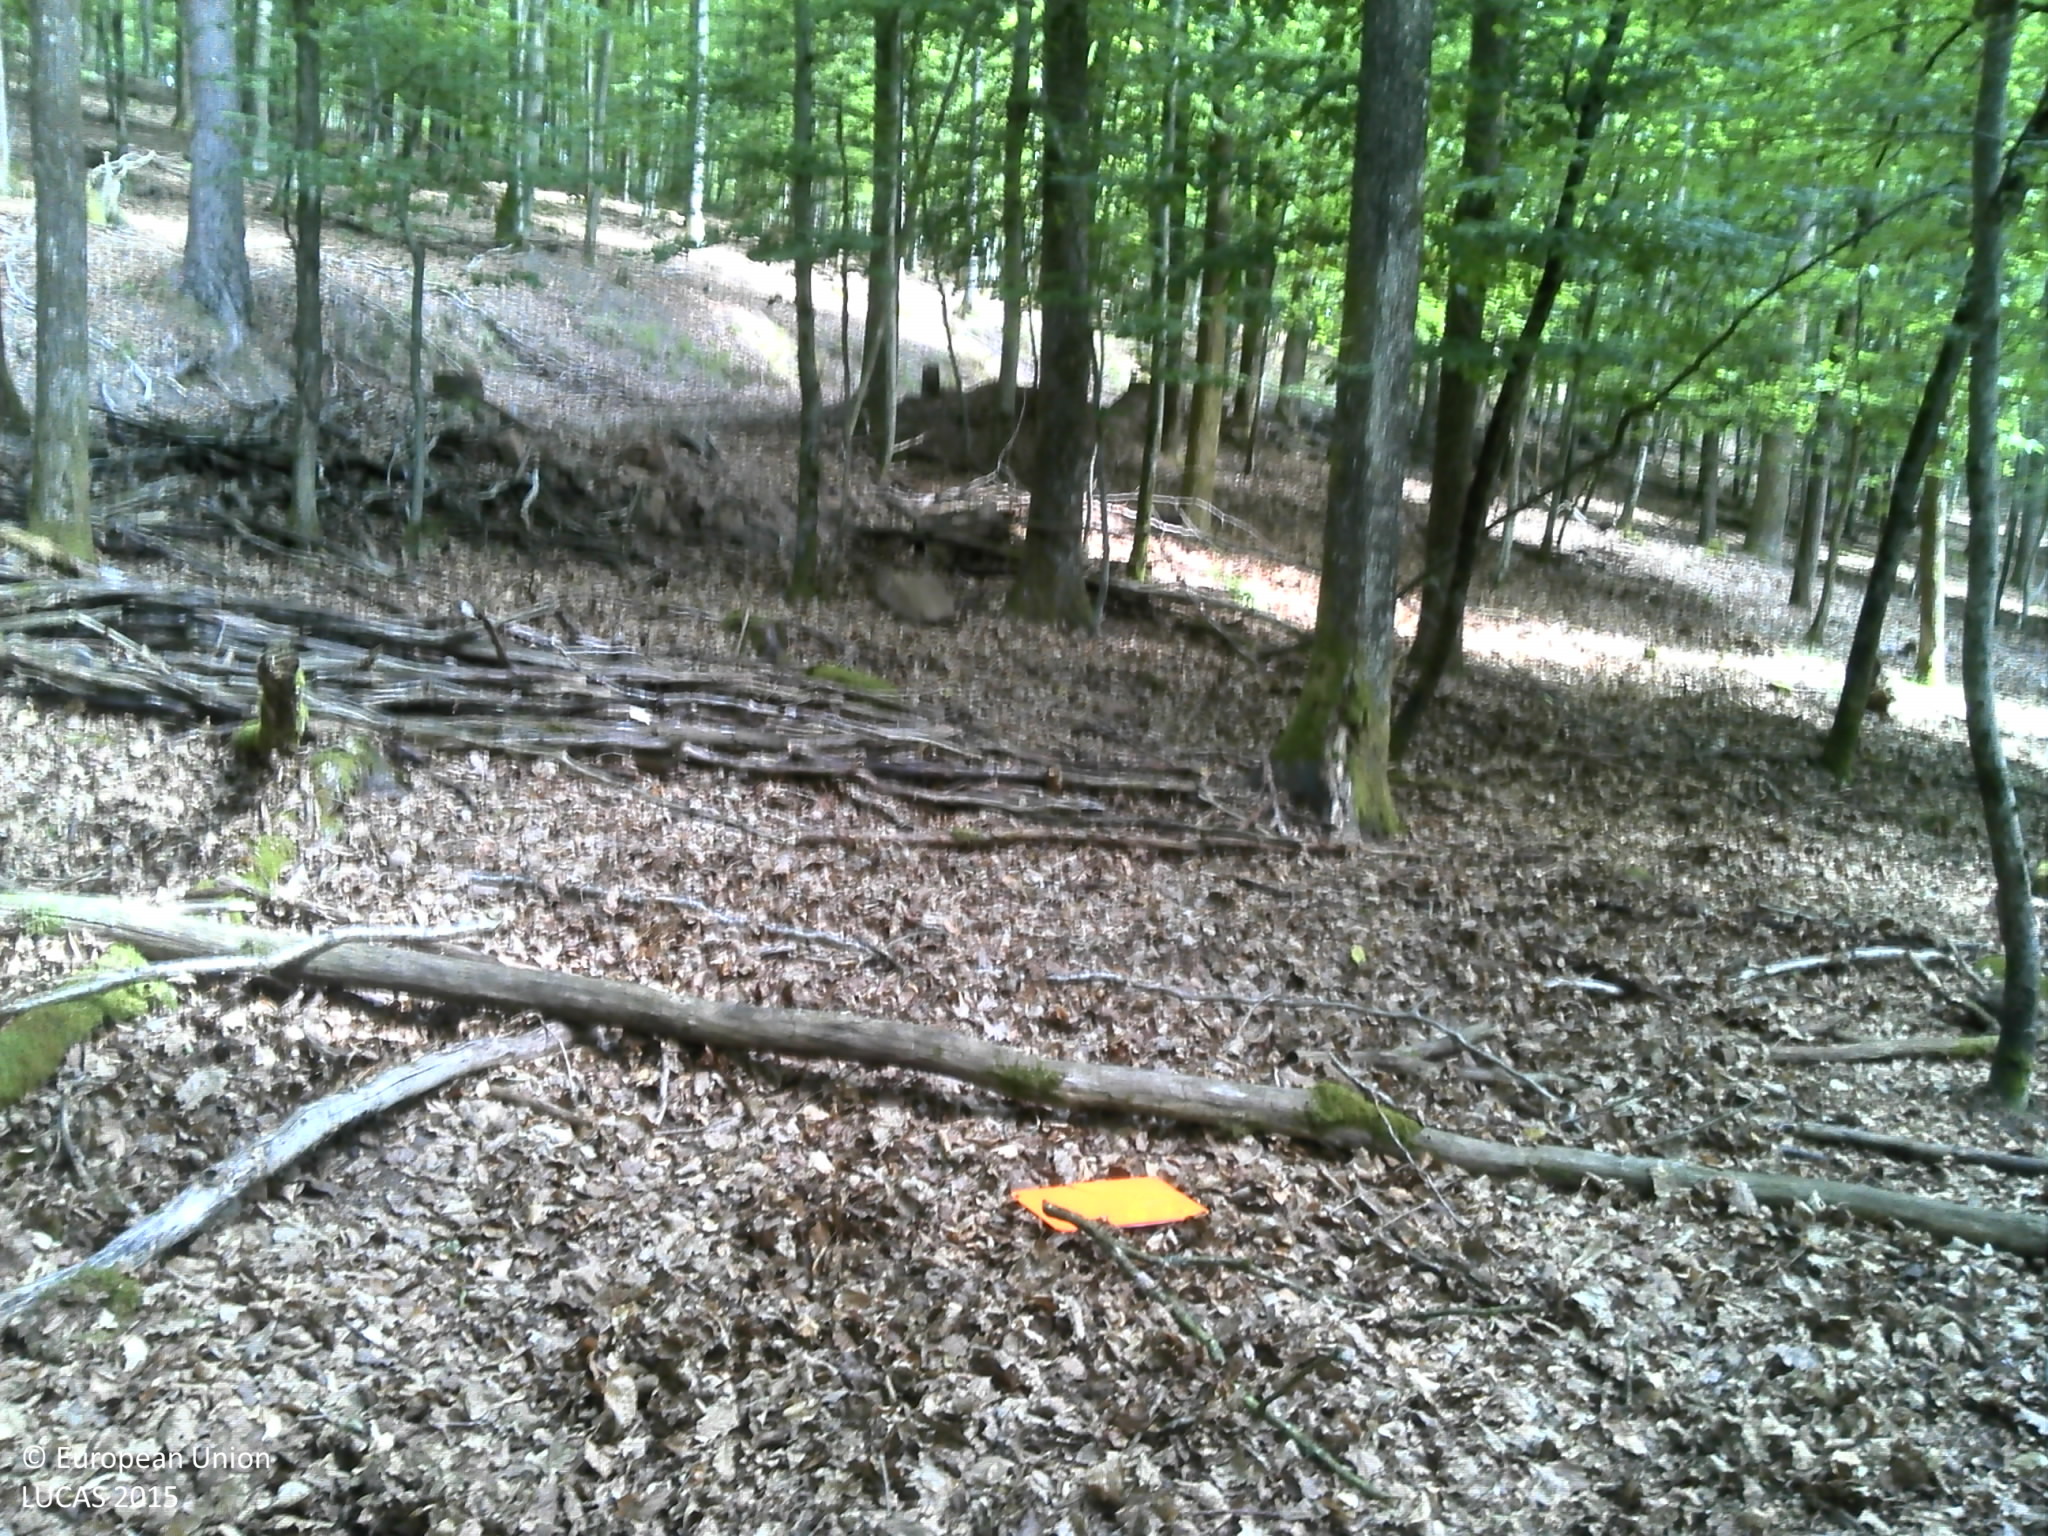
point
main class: Woodland
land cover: Broadleaved woodland
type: acidophilous oak and oak-birch forest
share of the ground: > 75 %
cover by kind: broadleaved forest trees 100 %
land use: Forestry
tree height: > 5 m
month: July
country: FR
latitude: 48.9513
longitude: 7.5017
